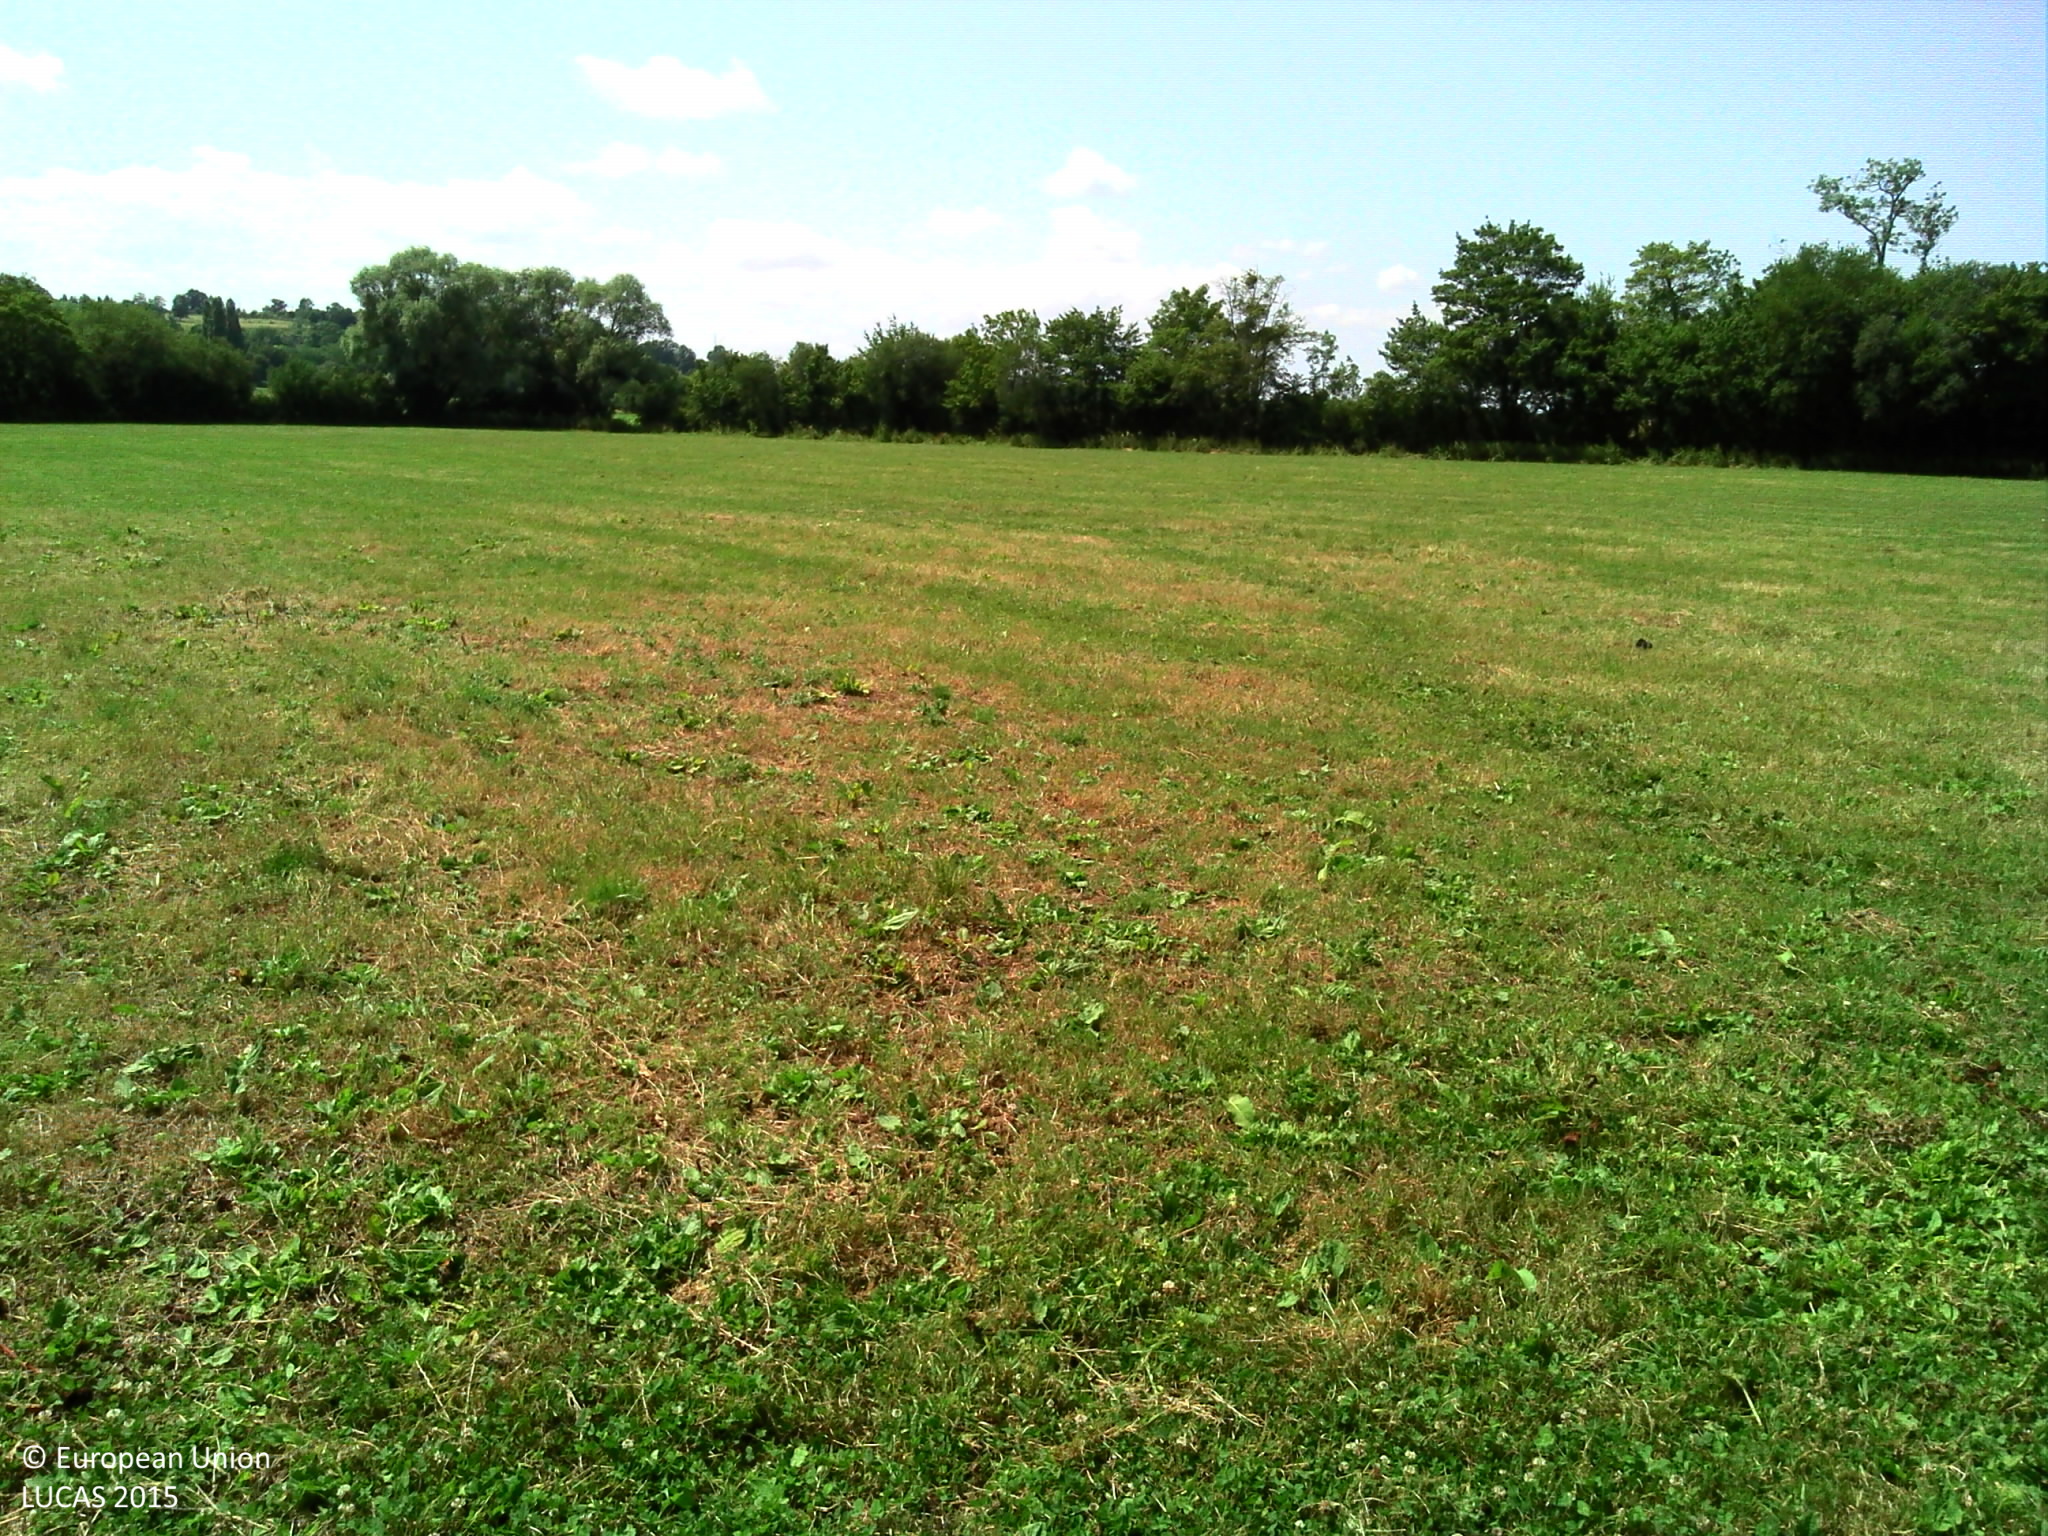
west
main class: Grassland
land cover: Grassland without tree/shrub cover
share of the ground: > 75 %
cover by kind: herbaceous plants 100 %
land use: Agriculture (excluding fallow land and kitchen gardens)
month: July
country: FR
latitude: 49.0898
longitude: -0.0136
